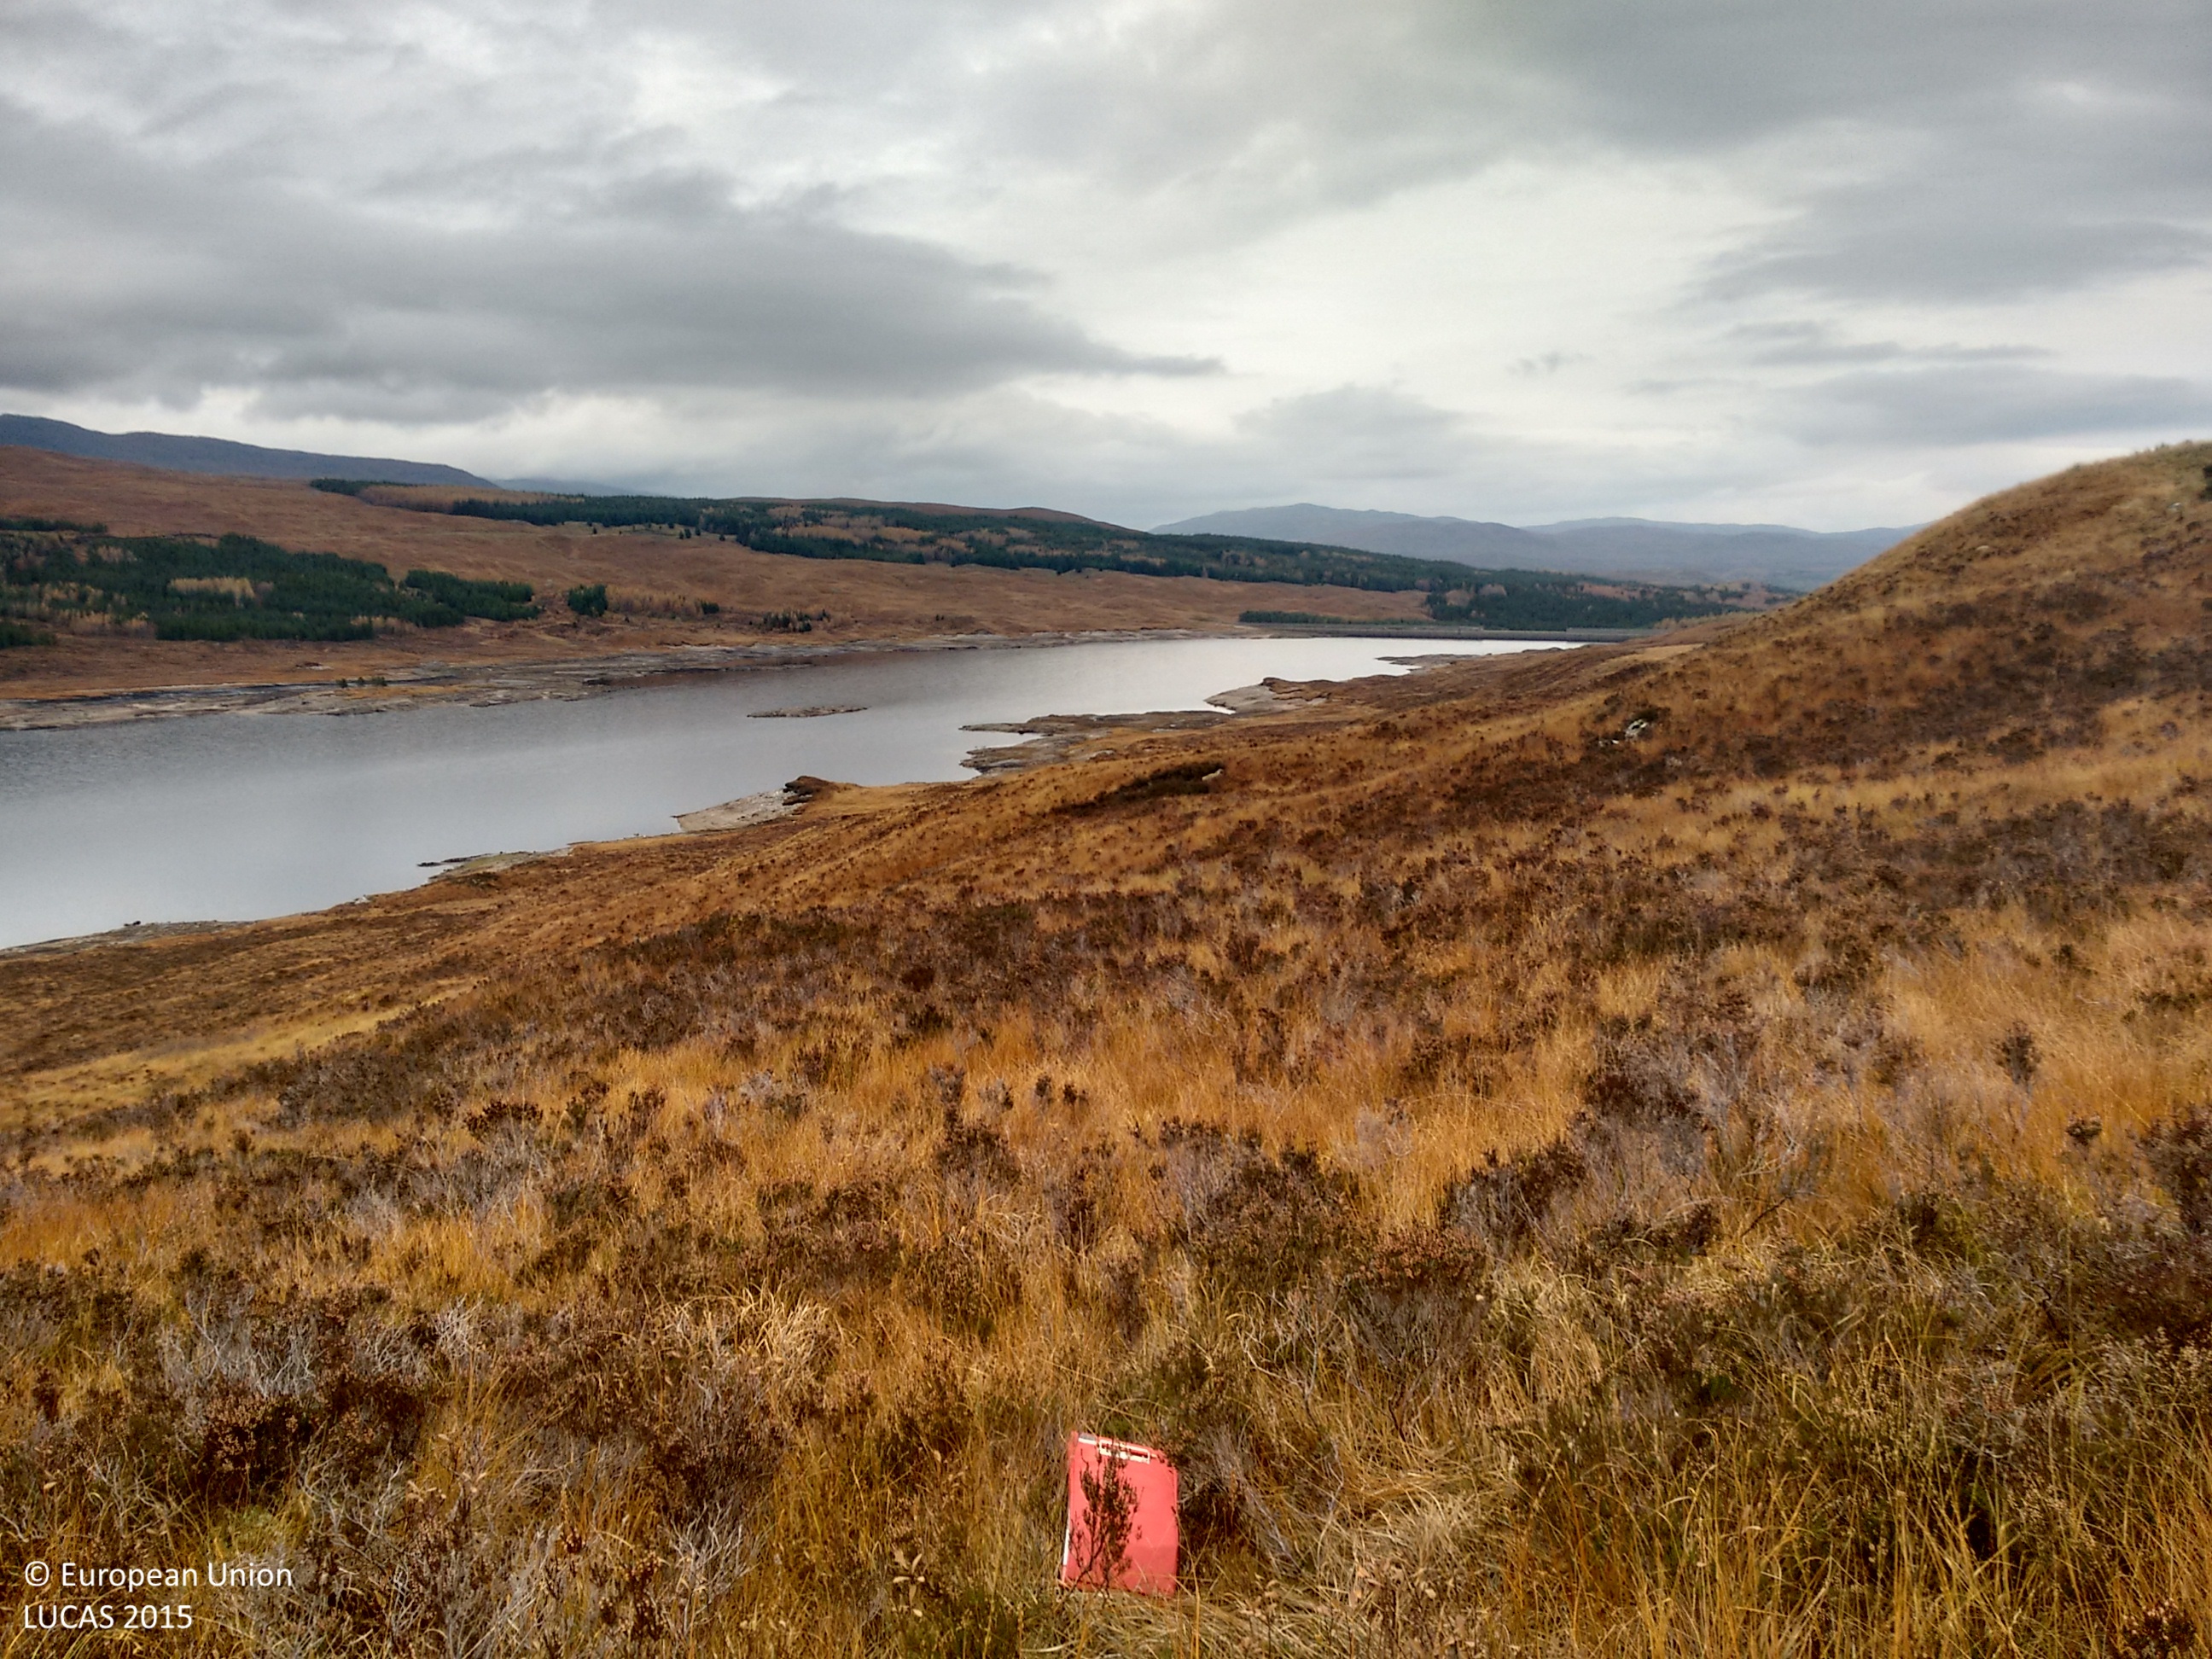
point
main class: Shrubland
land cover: Shrubland without tree cover
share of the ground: > 75 %
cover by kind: shrubs 70 %, herbaceous plants 20 %, lichens and mosses 10 %
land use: Agriculture (excluding fallow land and kitchen gardens)
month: November
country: GB
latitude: 57.1157
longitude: -4.9834
